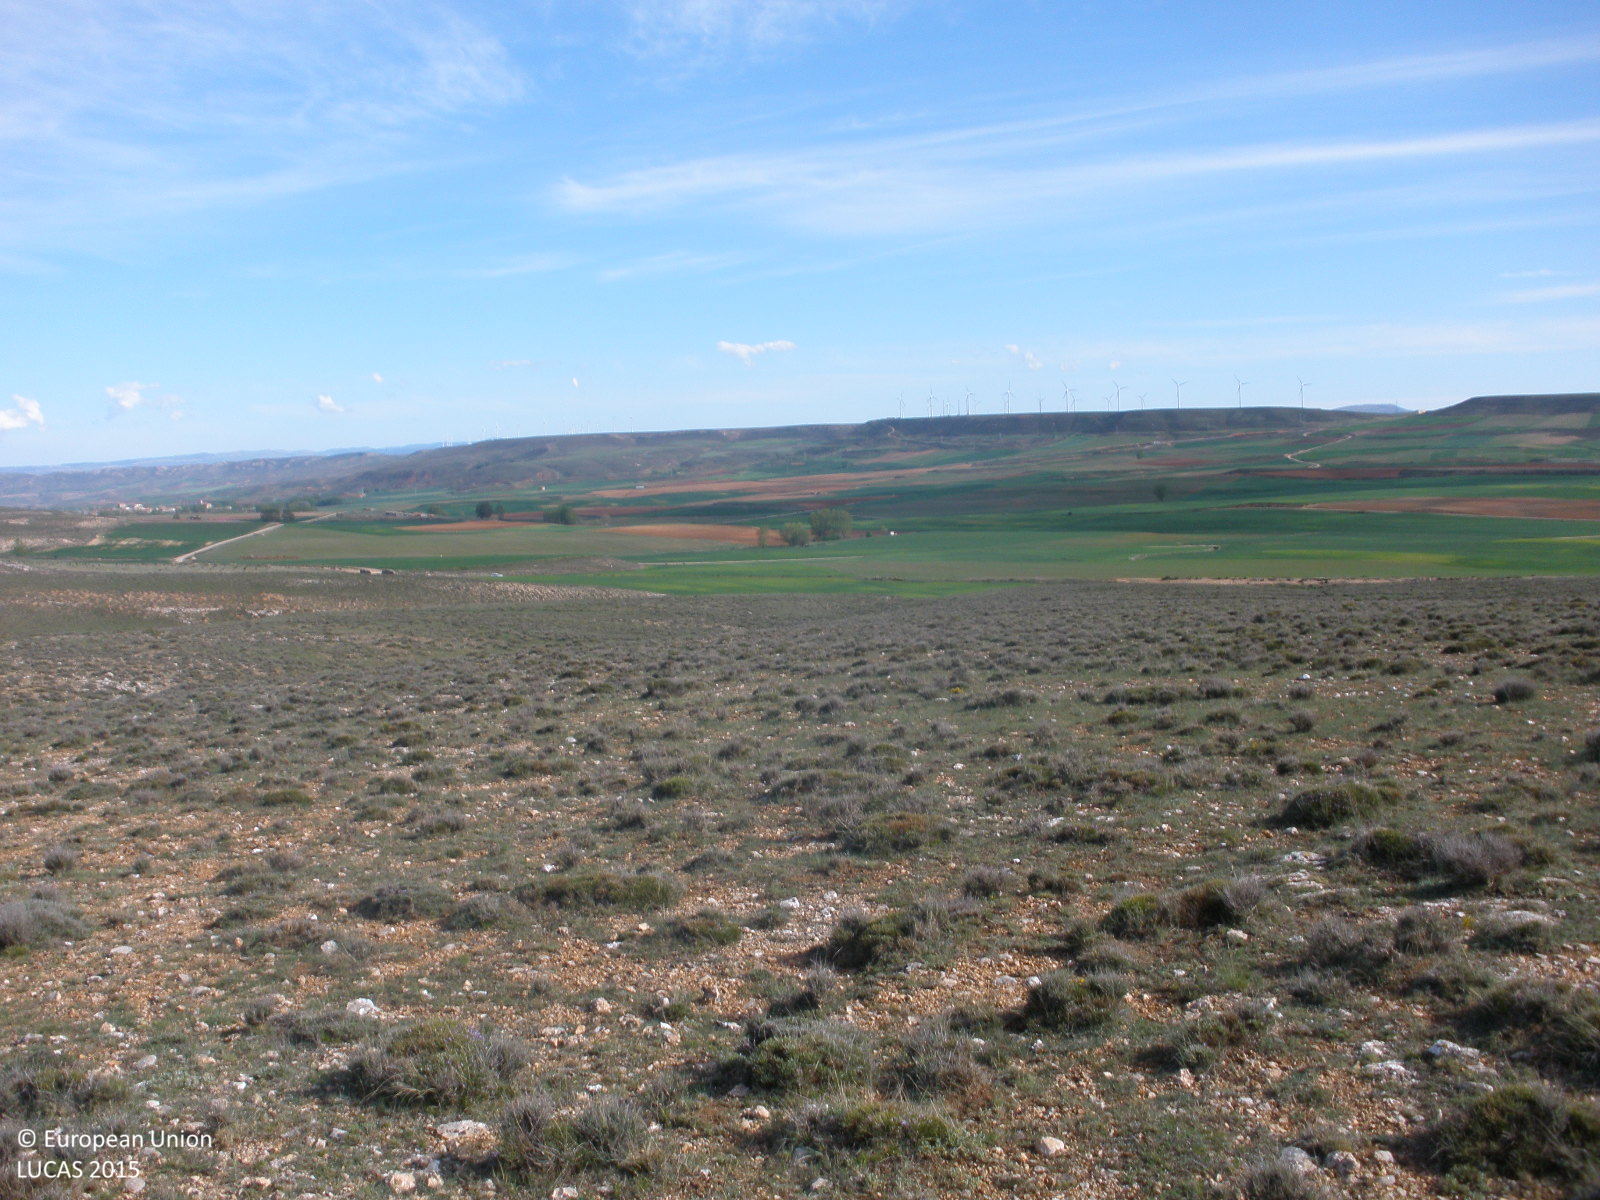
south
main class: Shrubland
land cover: Shrubland without tree cover
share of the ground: 50 - 75 %
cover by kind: shrubs 60 %, herbaceous plants 30 %, consolidated bare surface 10 %
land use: Semi-natural and natural areas not in use
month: May
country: ES
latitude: 40.7525
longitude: -0.8982
